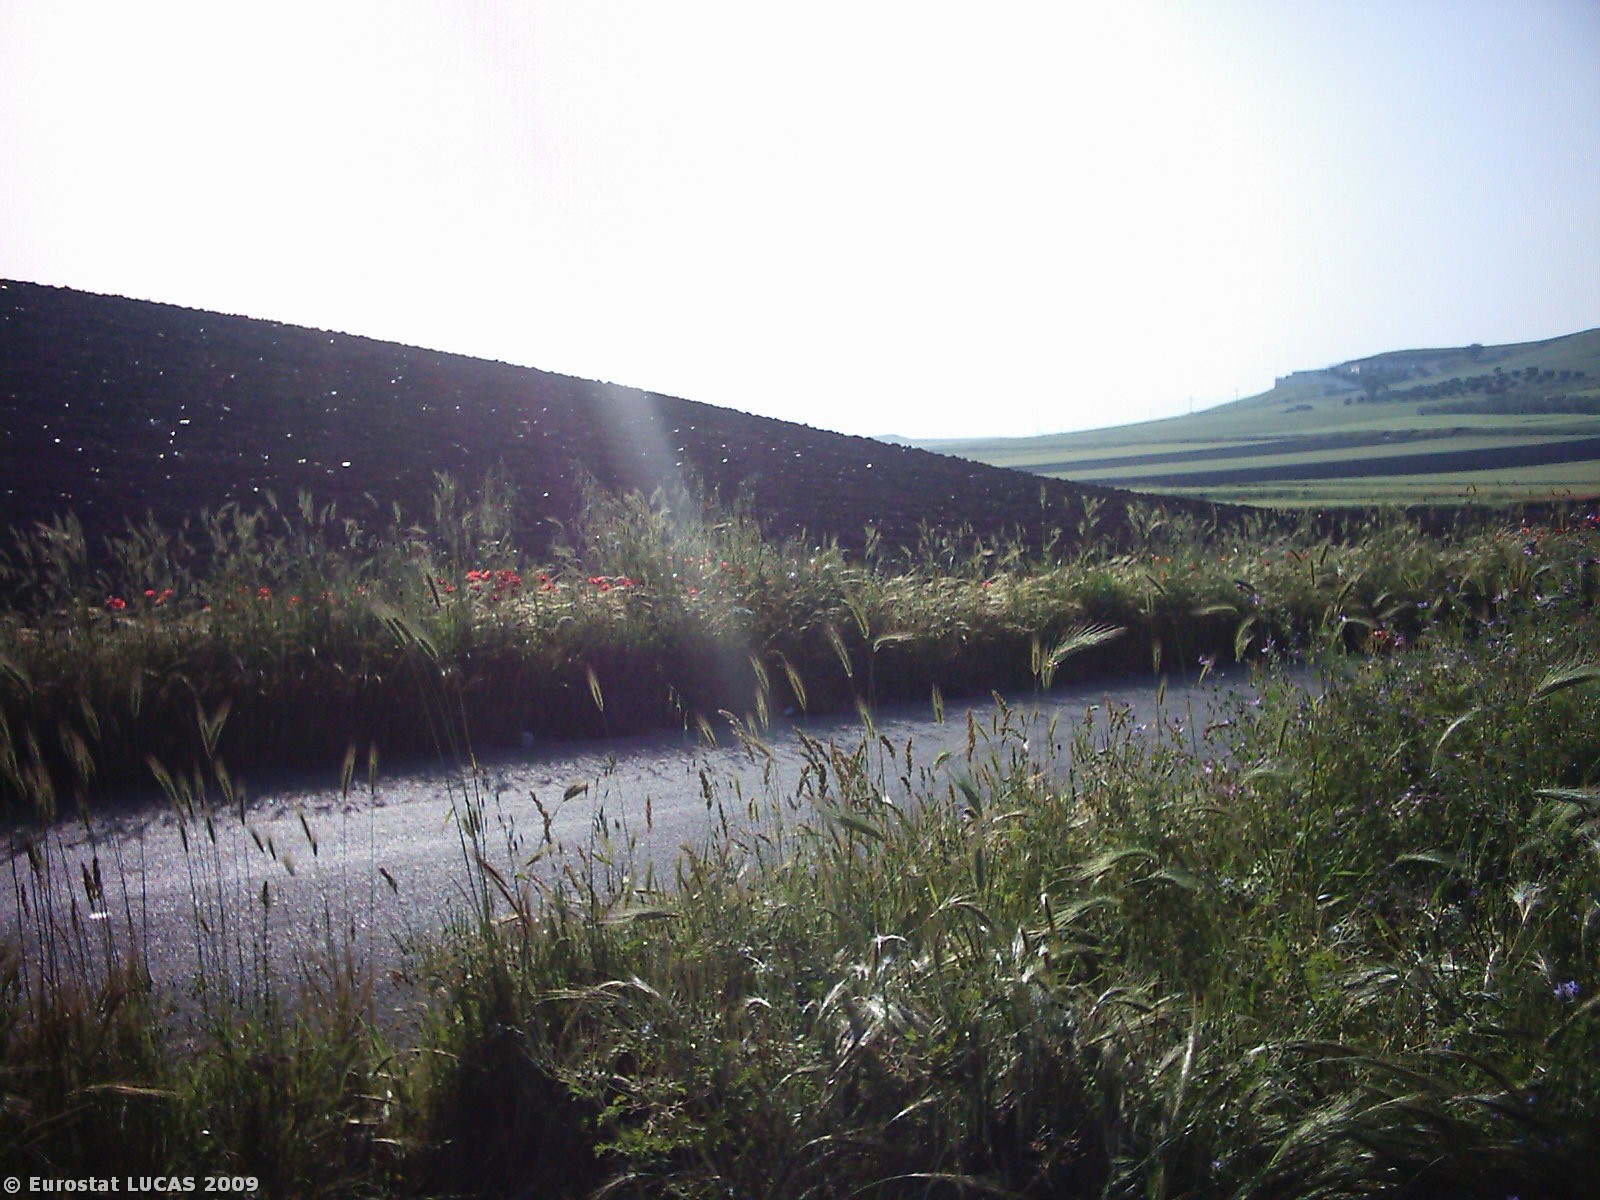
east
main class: Cropland
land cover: Durum wheat
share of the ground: > 75 %
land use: Agriculture (excluding fallow land and kitchen gardens)
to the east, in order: Durum wheat; Spontaneously vegetated surfaces; Paved roads, cycling and walking lanes; Grass margins; Ditches and canals; Grass margins; Bare land; Durum wheat
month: May
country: IT
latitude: 41.1623
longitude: 15.8556
